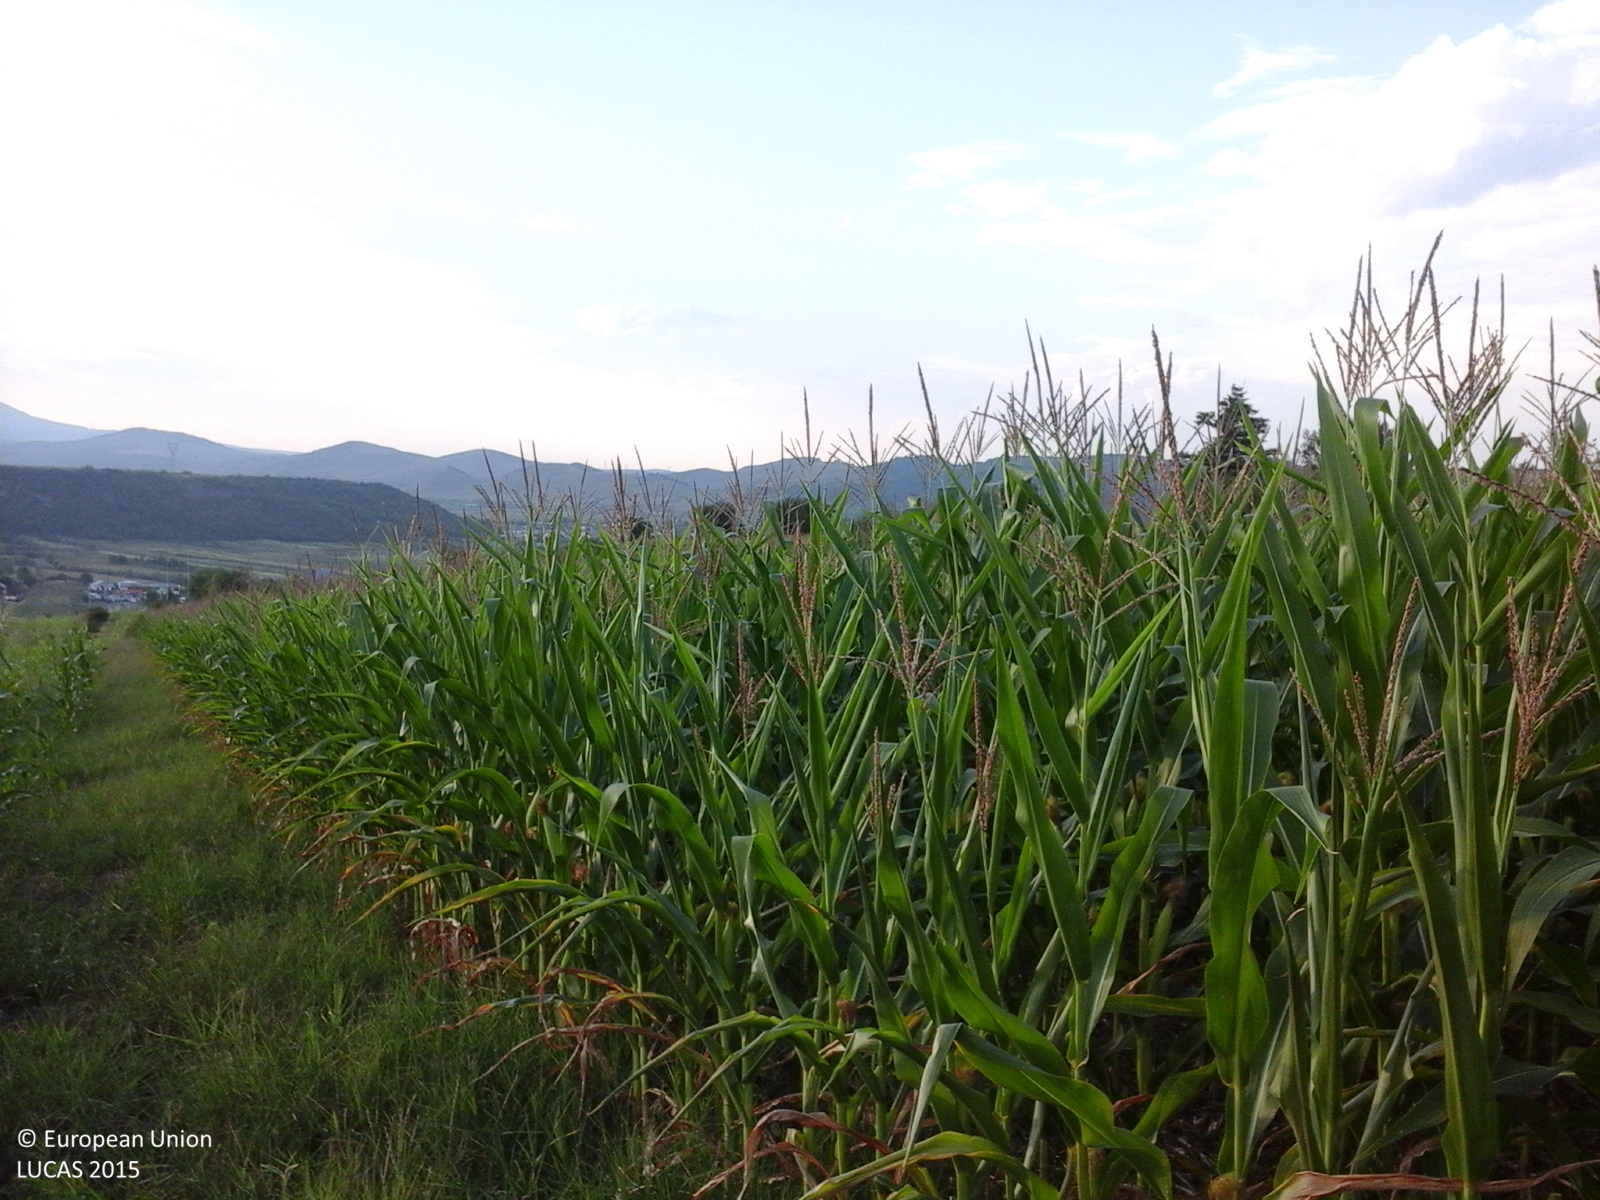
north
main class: Cropland
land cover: Maize
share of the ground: > 75 %
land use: Agriculture (excluding fallow land and kitchen gardens)
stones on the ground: < 10 %
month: July
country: RO
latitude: 46.2315
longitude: 26.7489
